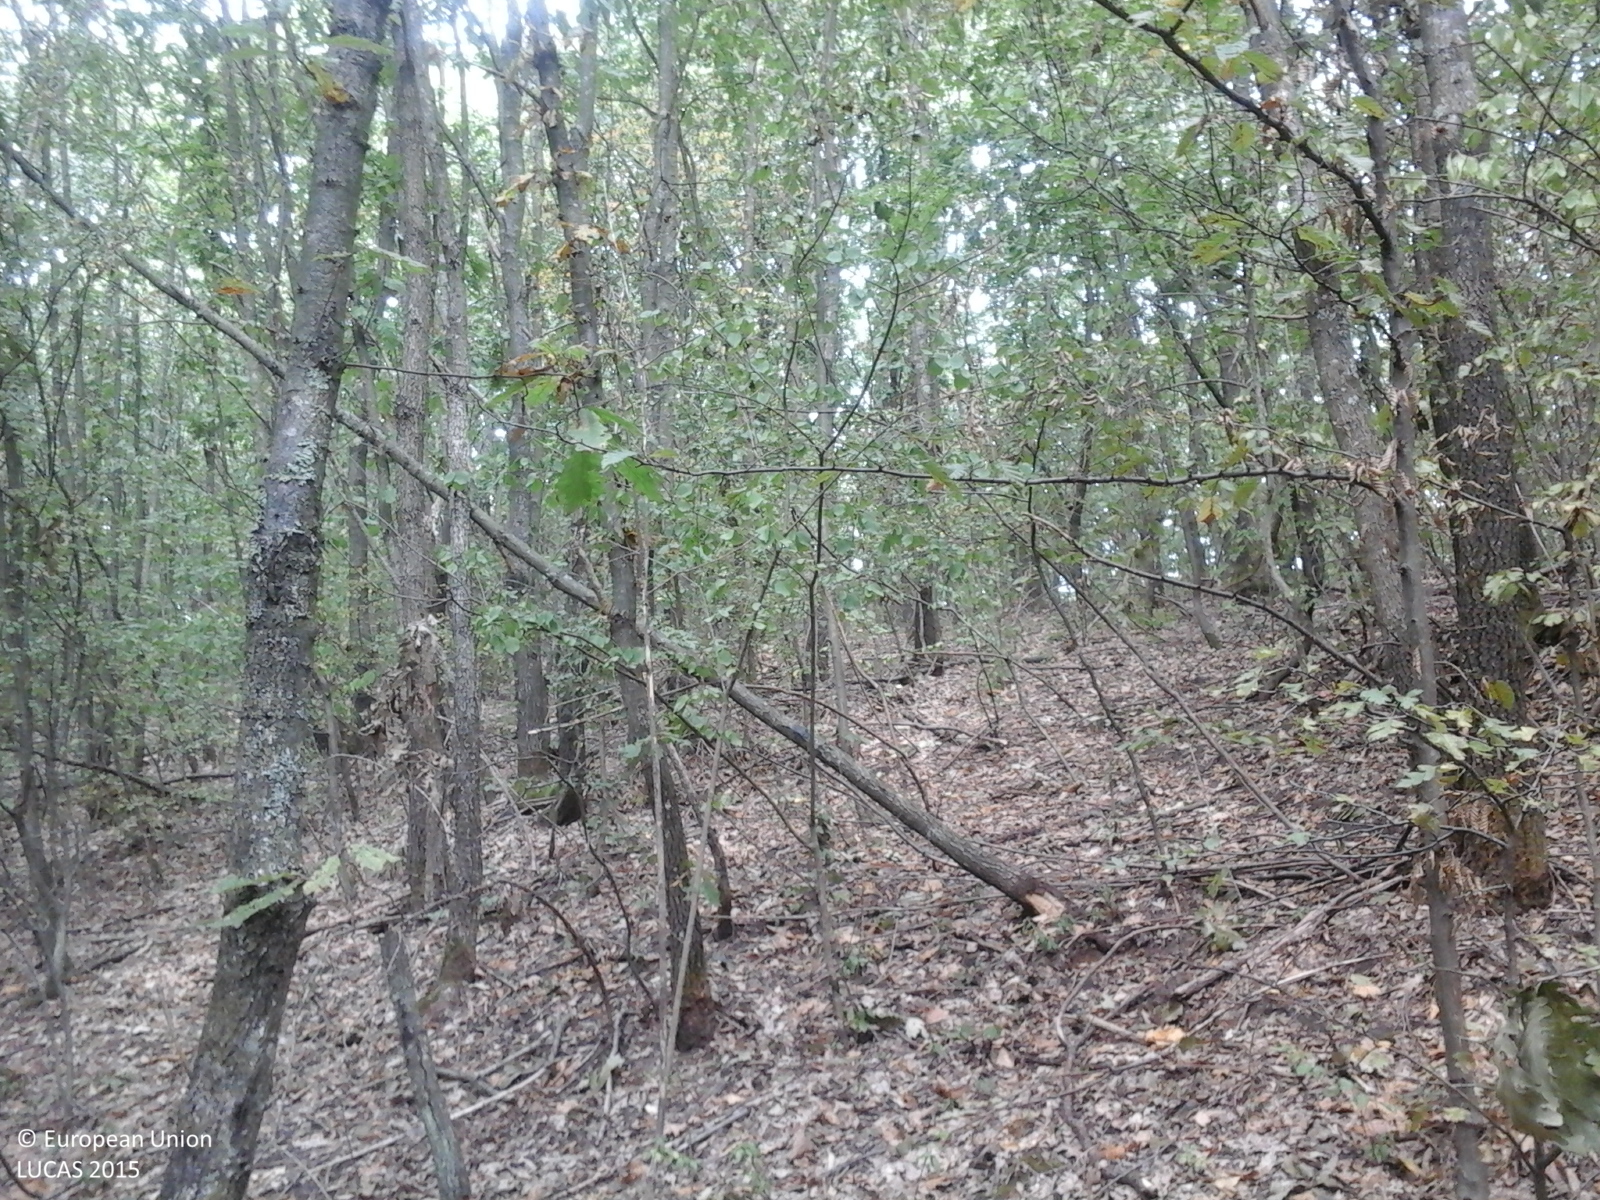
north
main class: Woodland
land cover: Broadleaved woodland
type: acidophilous oak and oak-birch forest
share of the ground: > 75 %
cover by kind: broadleaved forest trees 100 %
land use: Forestry
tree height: > 5 m
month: September
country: RO
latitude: 45.6946
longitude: 21.9695
